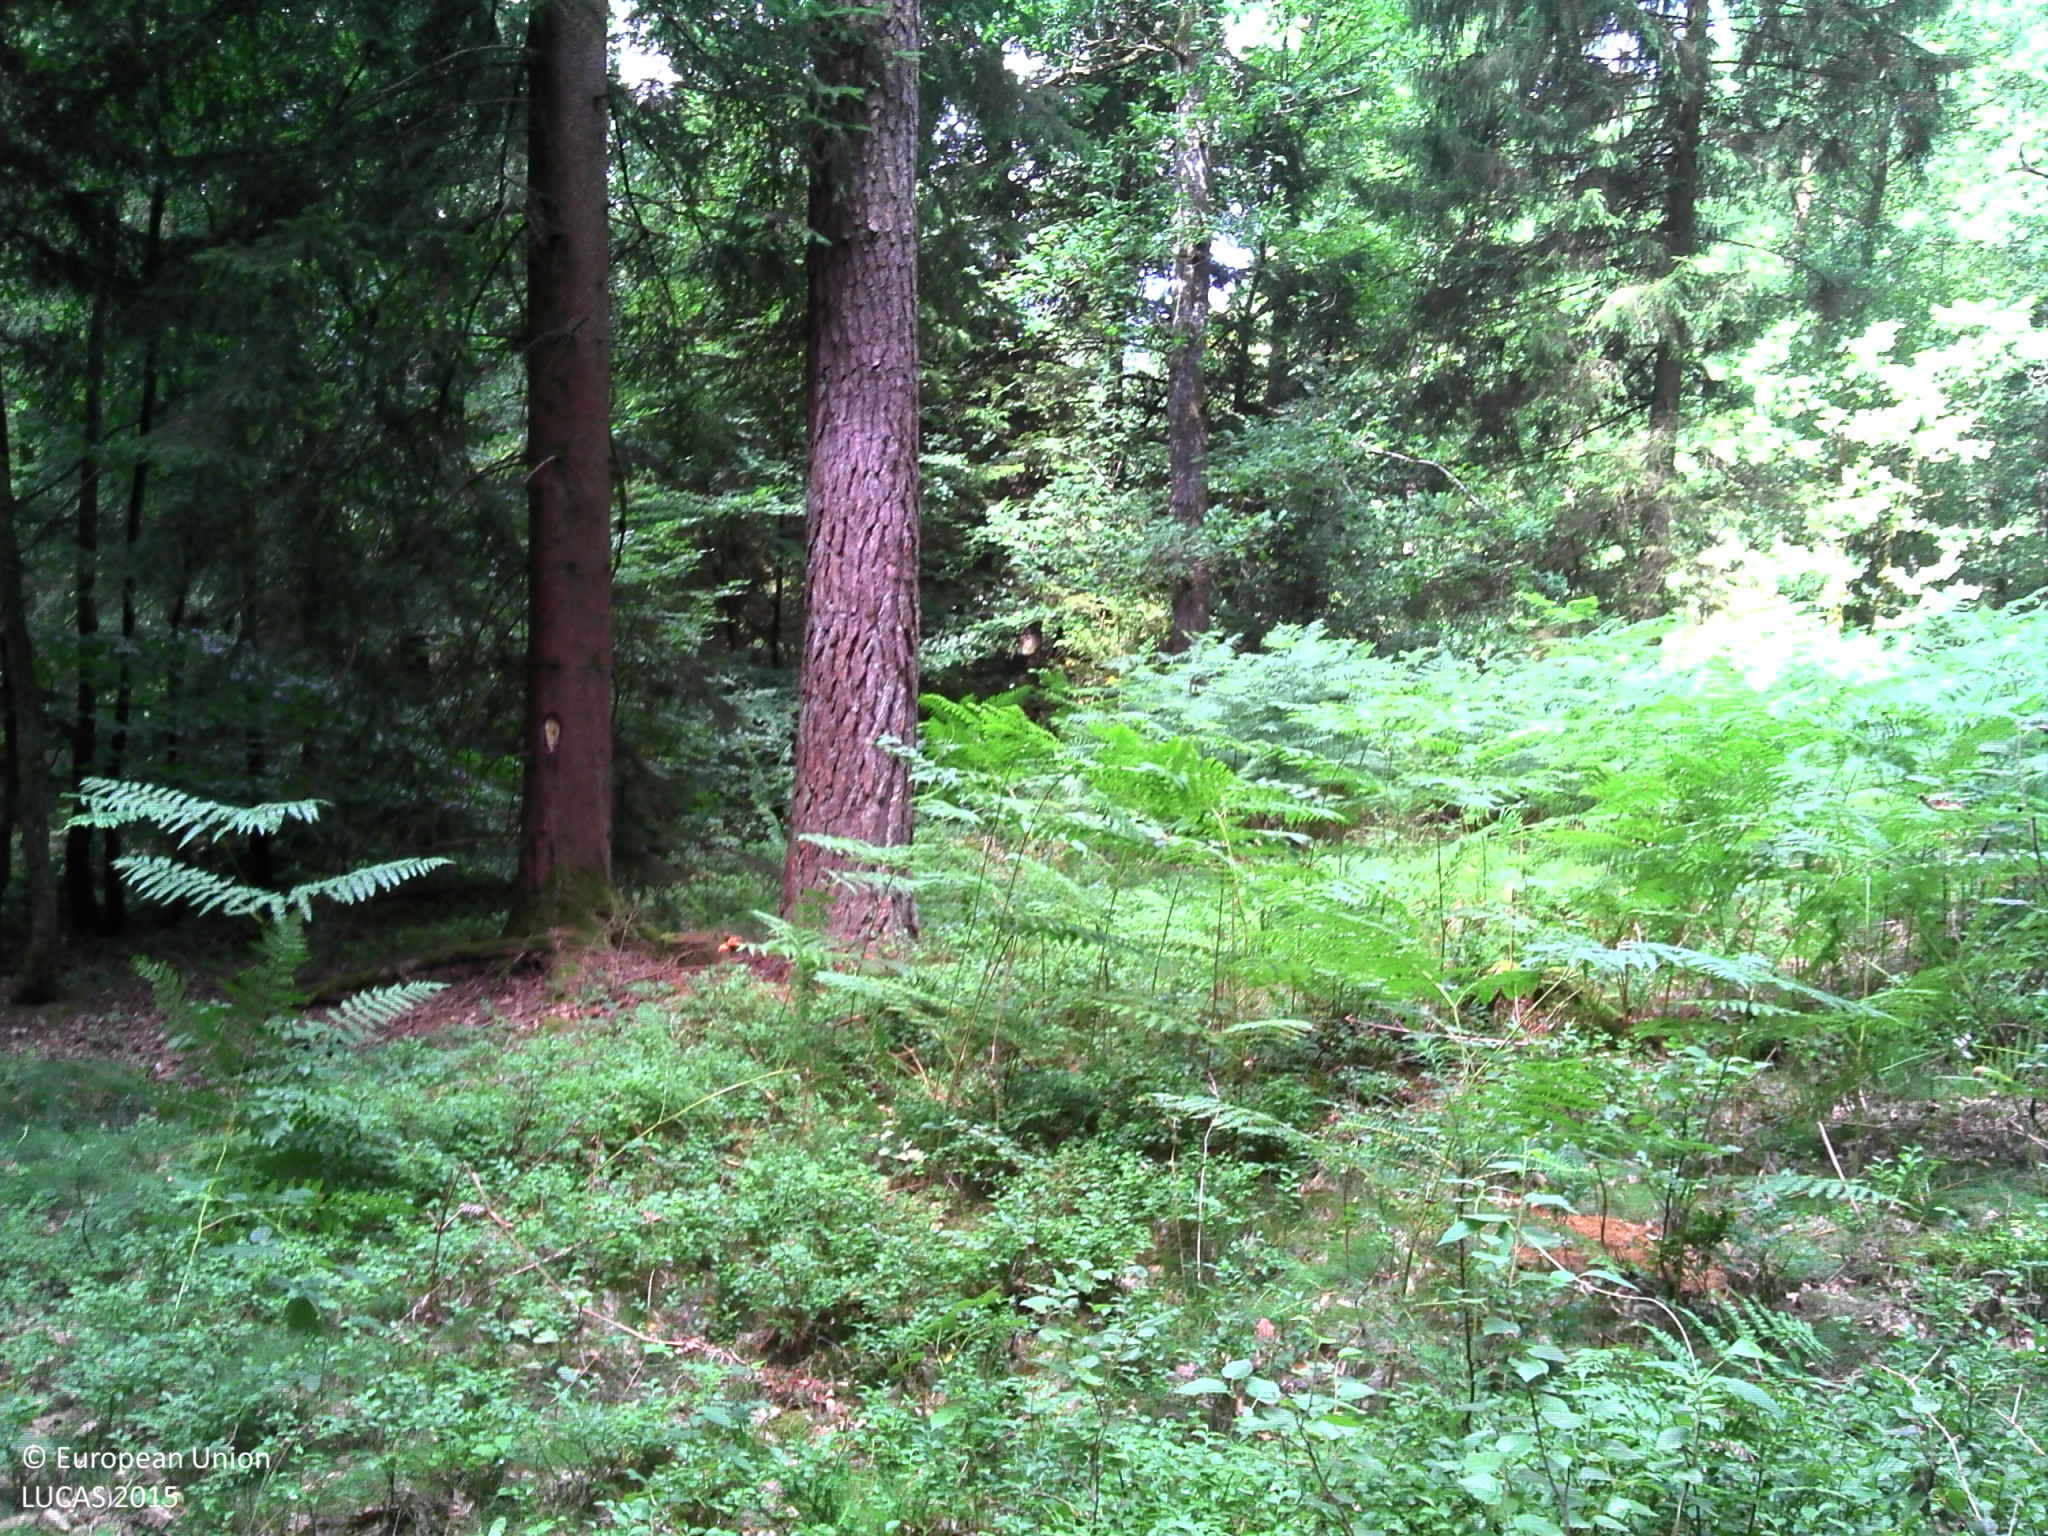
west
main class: Woodland
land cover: Broadleaved woodland
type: acidophilous oak and oak-birch forest
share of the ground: > 75 %
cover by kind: broadleaved forest trees 70 %, herbaceous plants 20 %, coniferous forest trees 10 %
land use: Forestry
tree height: > 5 m
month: July
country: BE
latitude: 49.6336
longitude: 5.6650
